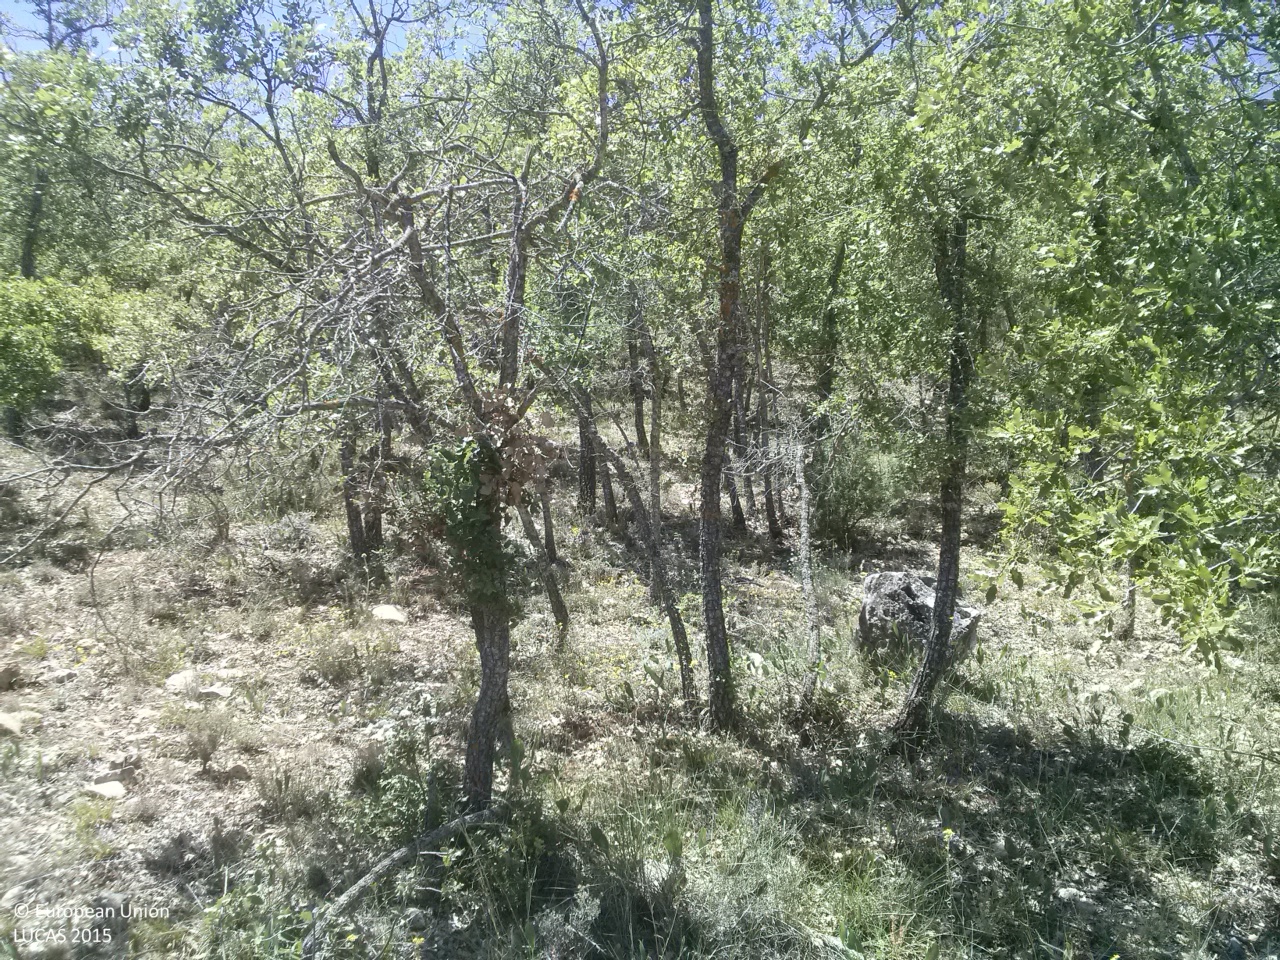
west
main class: Woodland
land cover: Broadleaved woodland
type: thermophilous deciduous forest
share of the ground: 50 - 75 %
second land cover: Grassland without tree/shrub cover
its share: 50 - 75 %
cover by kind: broadleaved forest trees 65 %, herbaceous plants 30 %, shrubs 5 %
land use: Forestry
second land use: Agriculture (excluding fallow land and kitchen gardens)
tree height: > 5 m
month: May
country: ES
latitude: 40.2865
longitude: -2.7872
